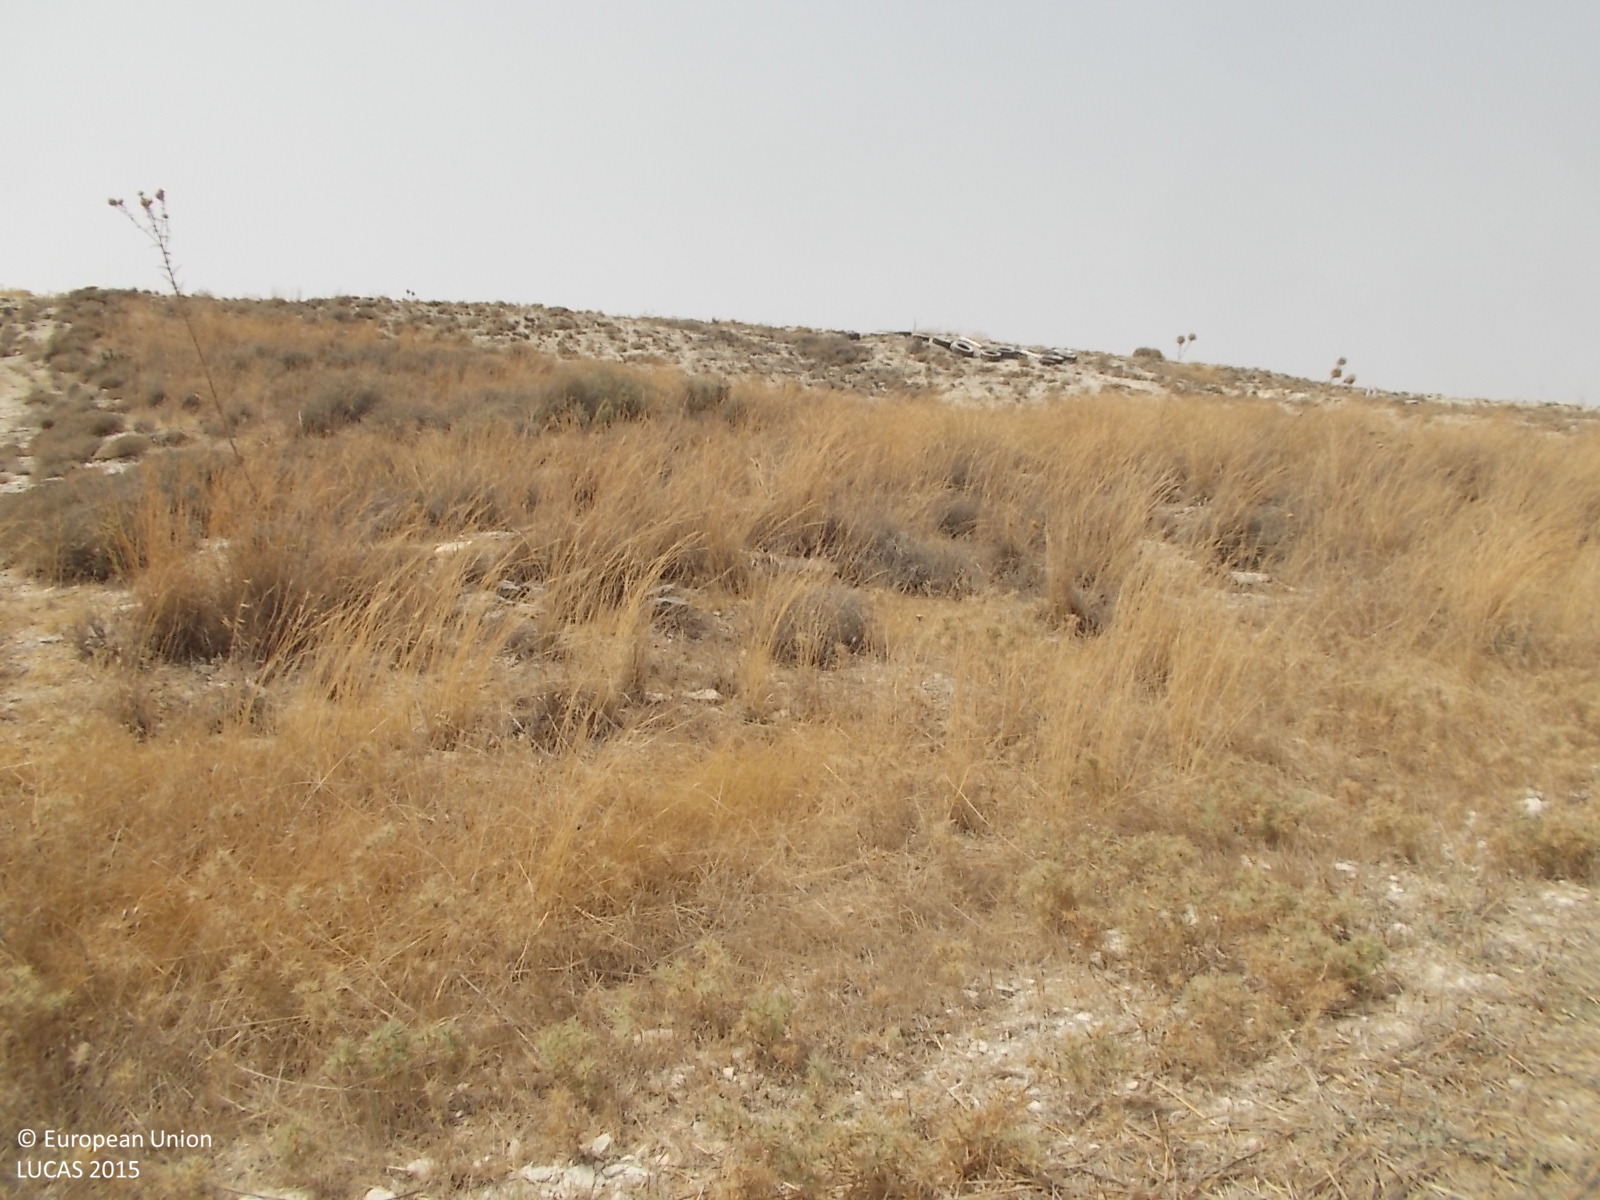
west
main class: Cropland
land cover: Mixed cereals for fodder
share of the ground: < 10 %
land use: Agriculture (excluding fallow land and kitchen gardens)
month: April
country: CY
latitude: 34.9225
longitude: 33.5189
